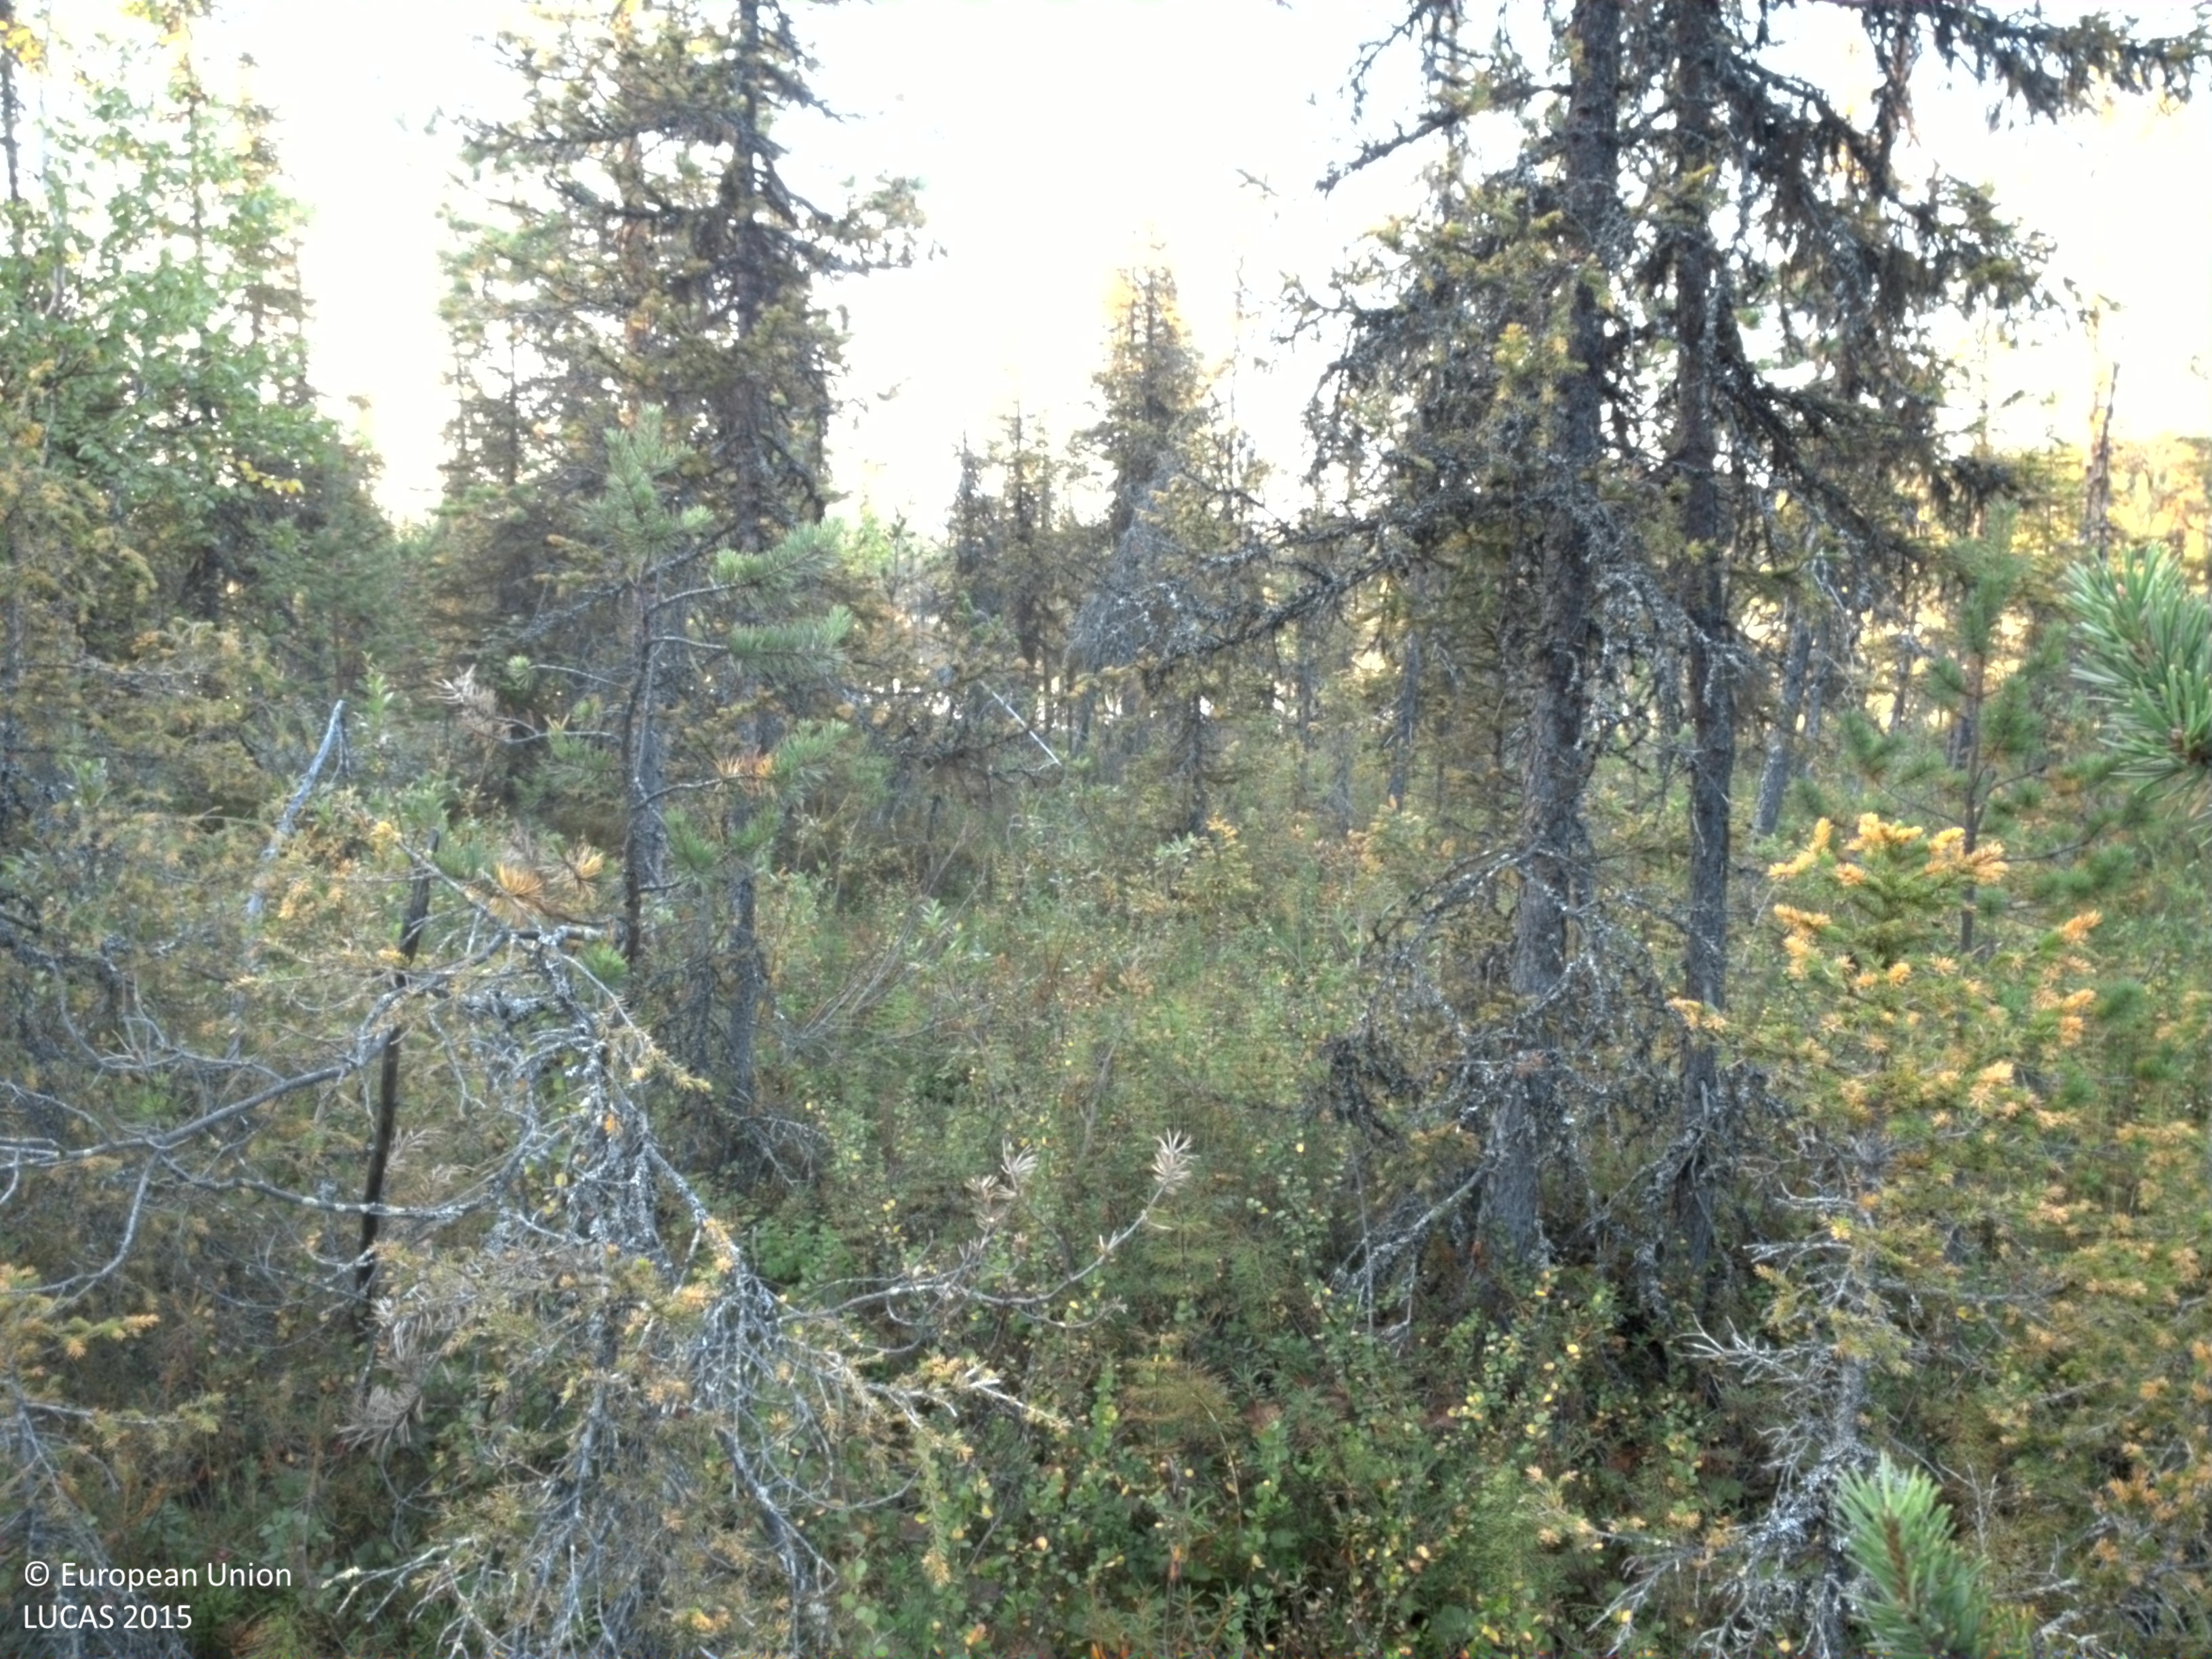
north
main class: Woodland
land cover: Spruce dominated coniferous woodland
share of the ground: 25 - 50 %
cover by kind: shrubs 70 %, coniferous forest trees 30 %
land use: Forestry
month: August
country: SE
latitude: 66.7285
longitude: 19.9996
